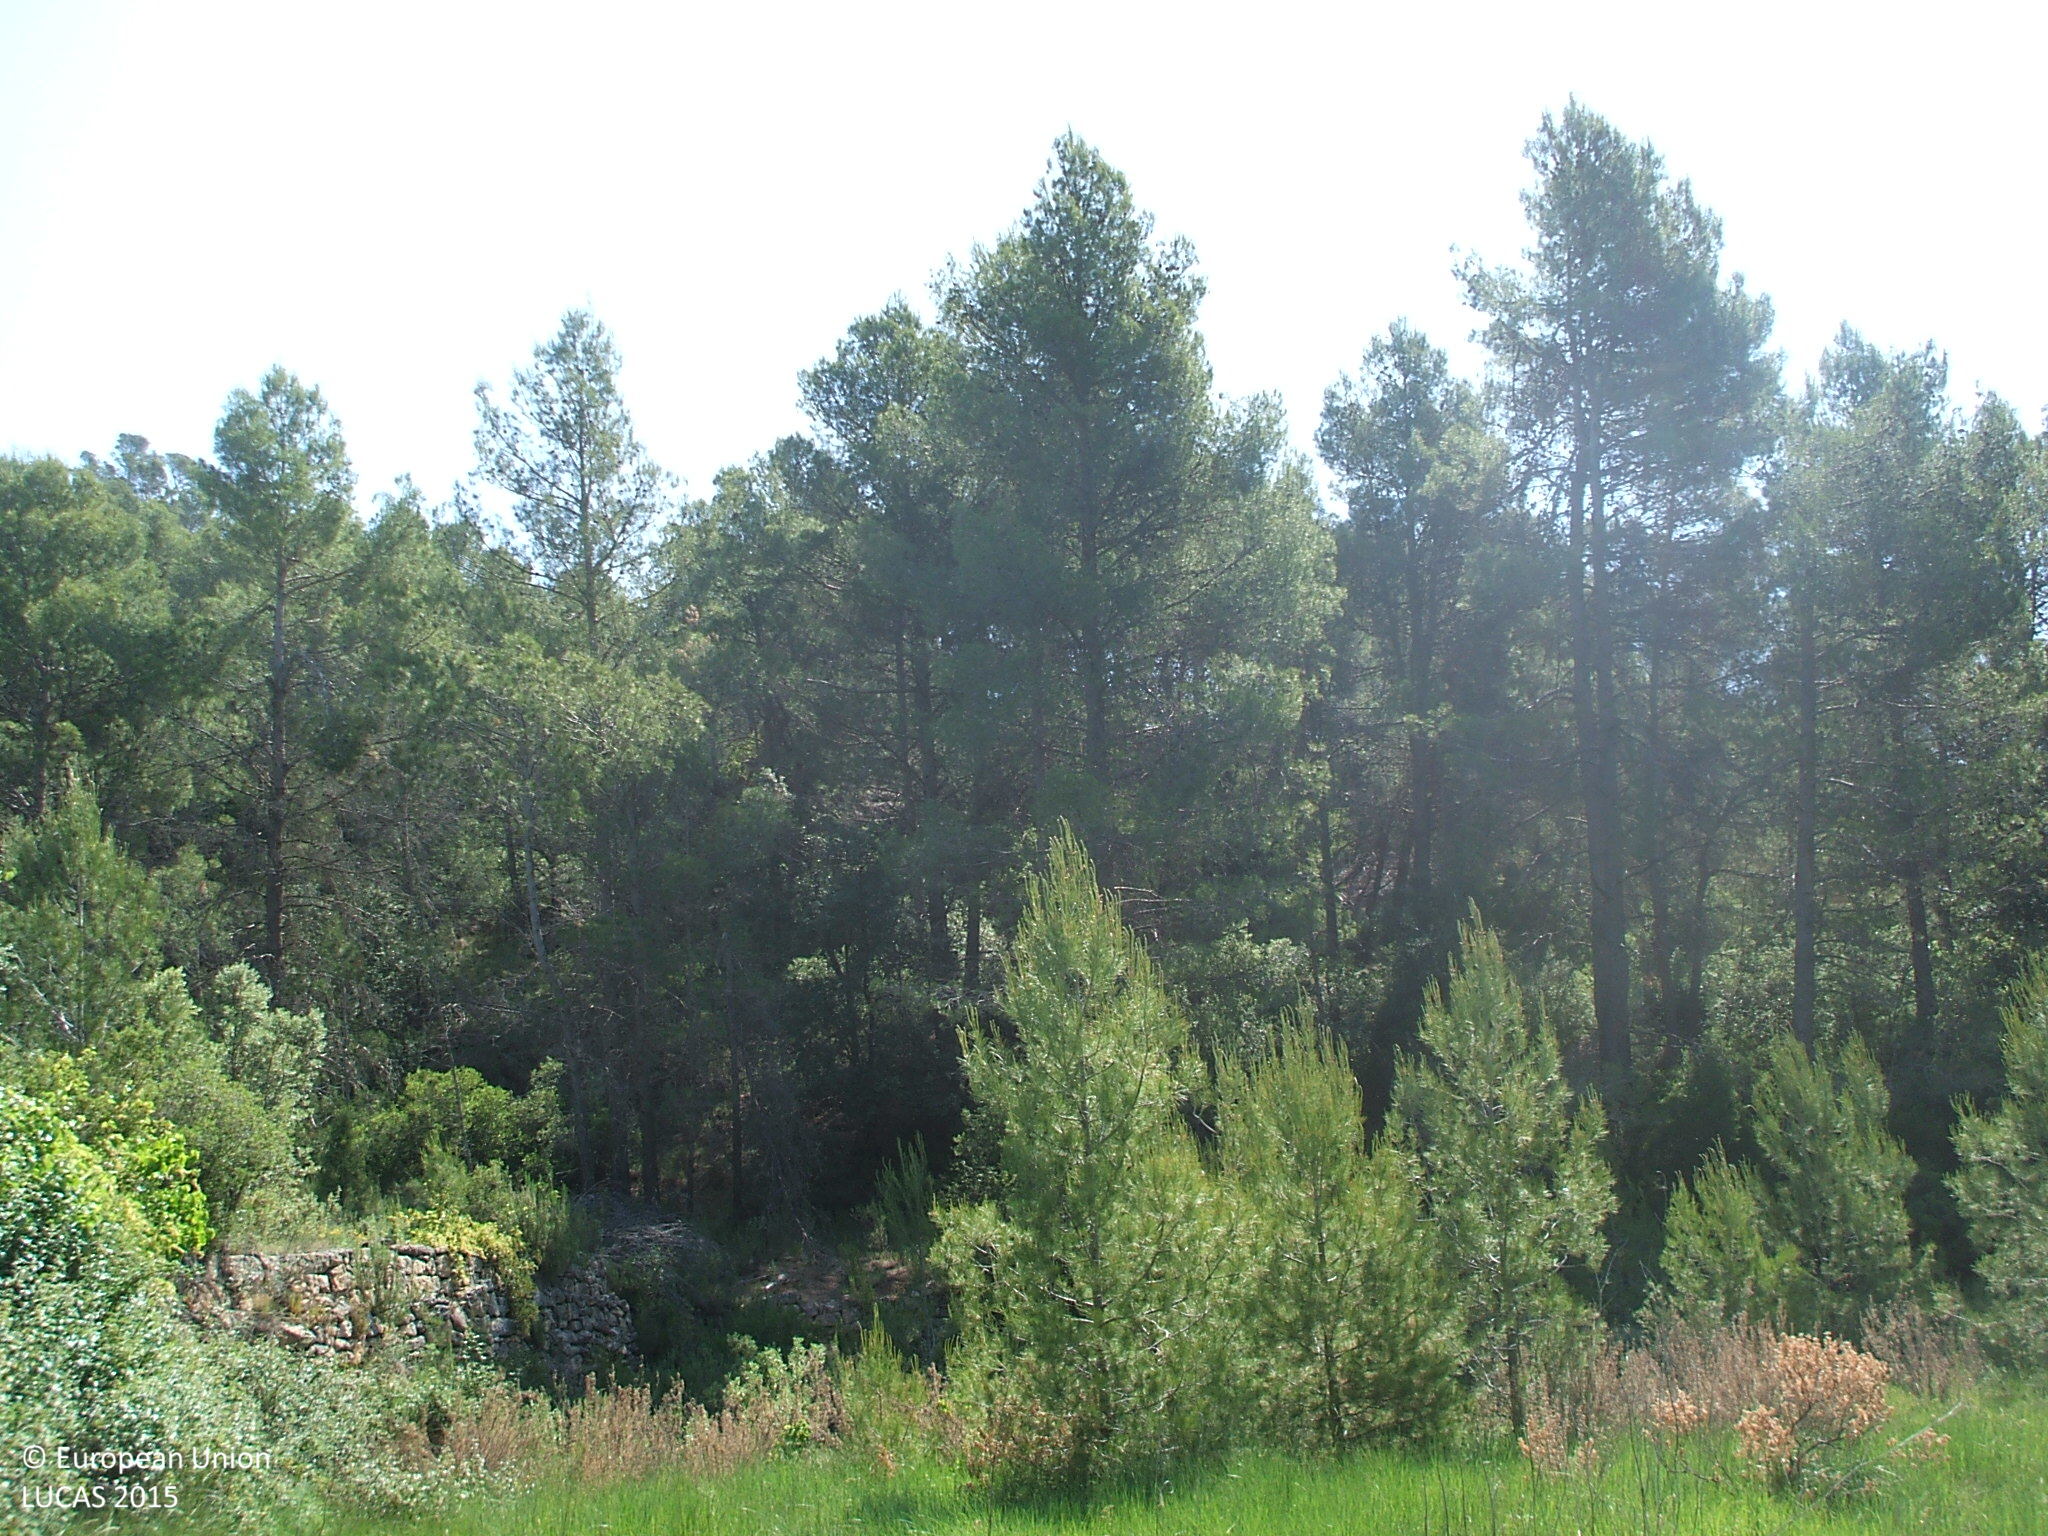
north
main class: Grassland
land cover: Grassland with sparse tree/shrub cover
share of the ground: > 75 %
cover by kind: herbaceous plants 95 %, coniferous forest trees 5 %
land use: Semi-natural and natural areas not in use
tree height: > 5 m
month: June
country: ES
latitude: 40.9009
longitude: -0.0164
